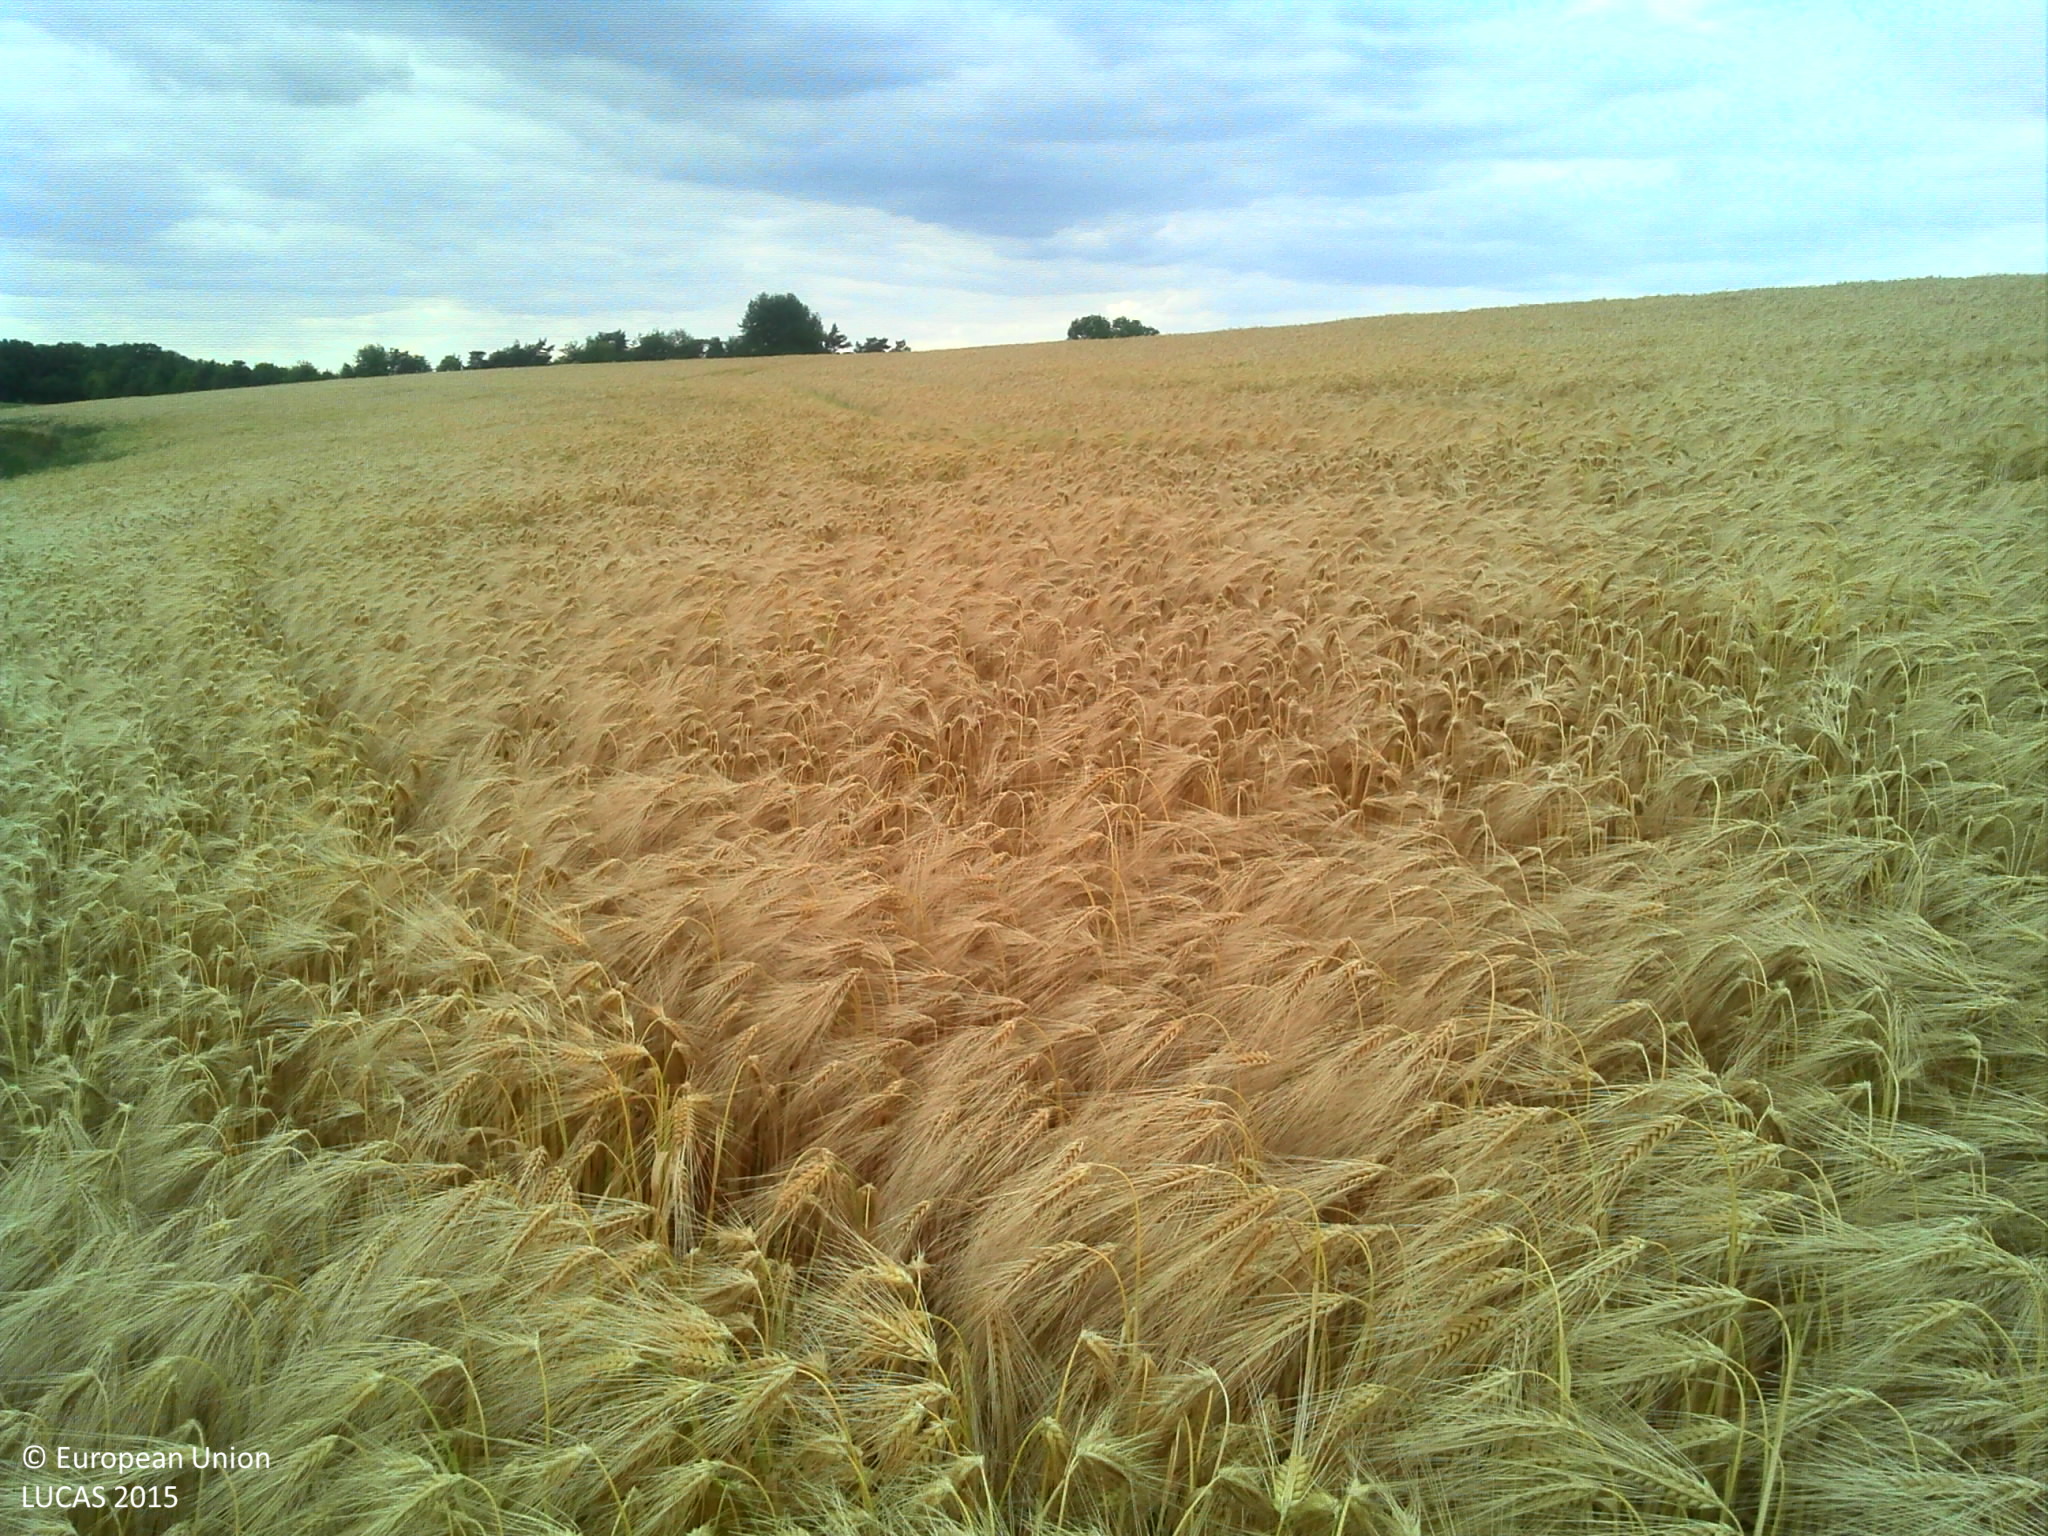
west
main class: Cropland
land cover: Barley
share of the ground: > 75 %
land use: Agriculture (excluding fallow land and kitchen gardens)
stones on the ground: < 10 %
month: June
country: FR
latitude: 49.4323
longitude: 3.6921
